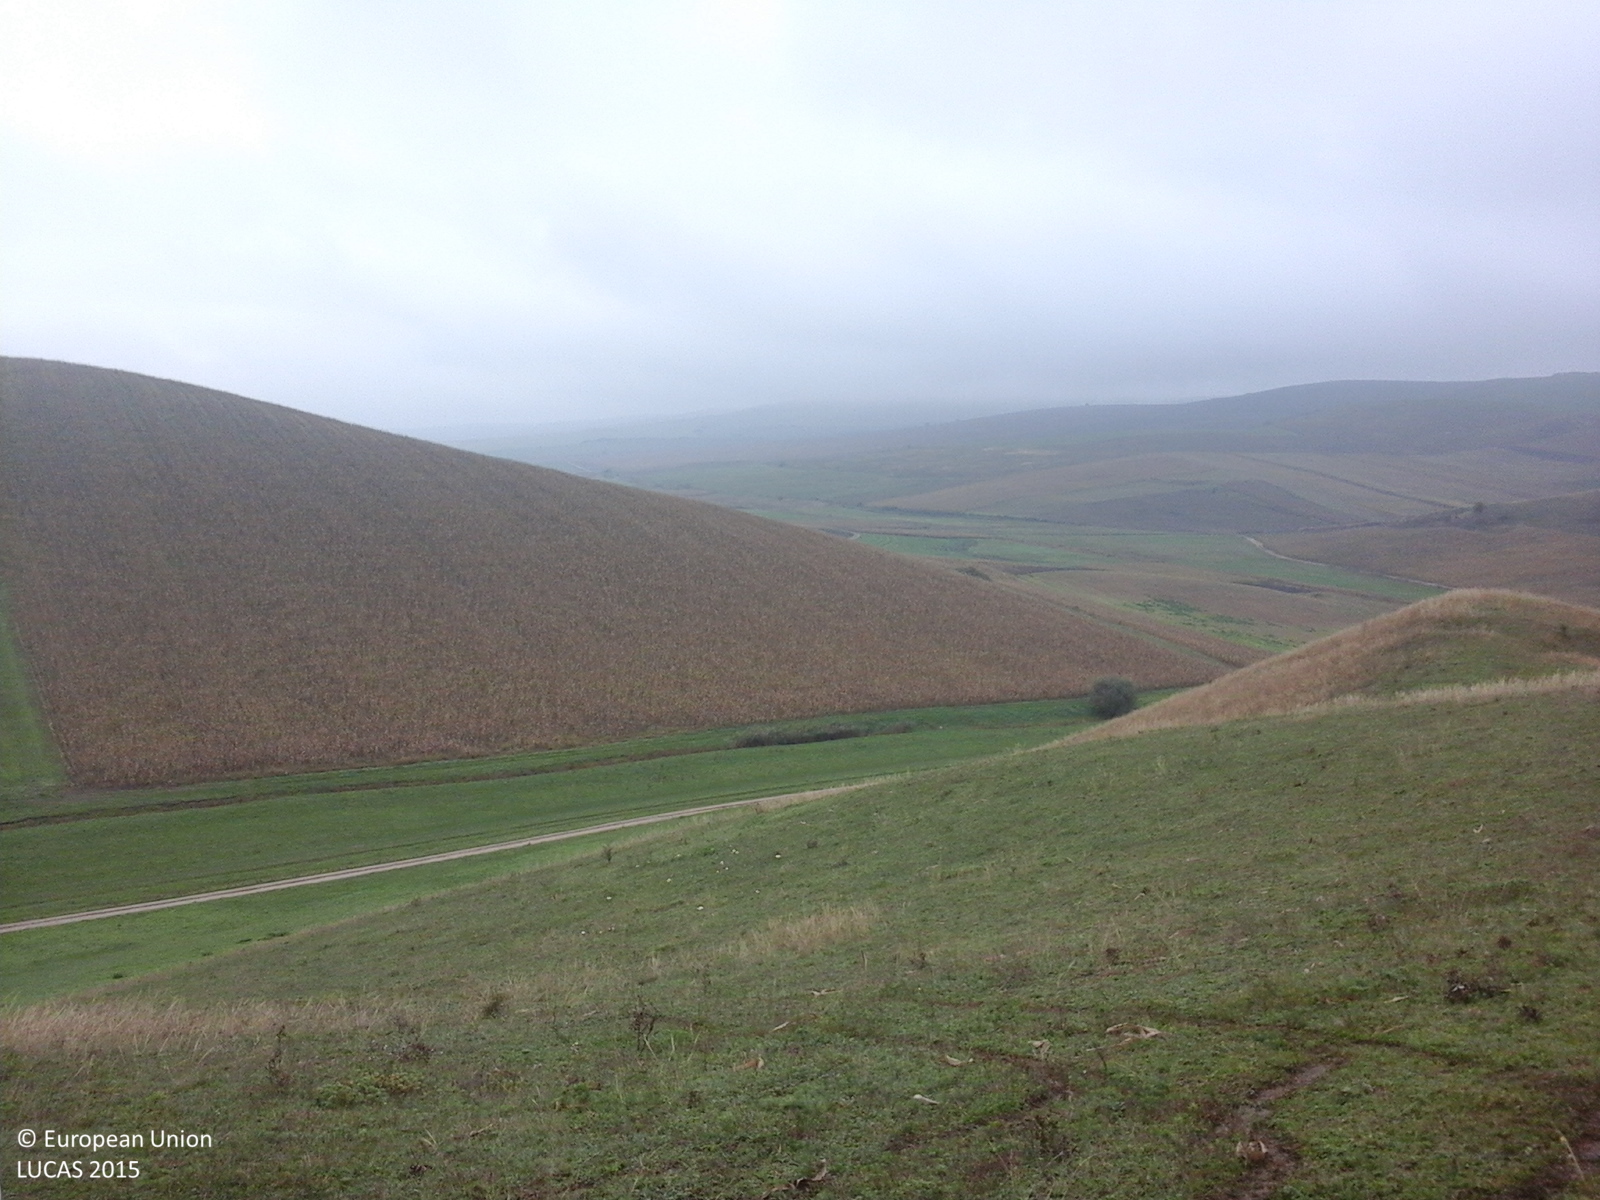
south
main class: Grassland
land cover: Grassland without tree/shrub cover
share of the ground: > 75 %
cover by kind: herbaceous plants 100 %
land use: Agriculture (excluding fallow land and kitchen gardens)
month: October
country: RO
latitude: 46.6246
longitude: 23.9066
